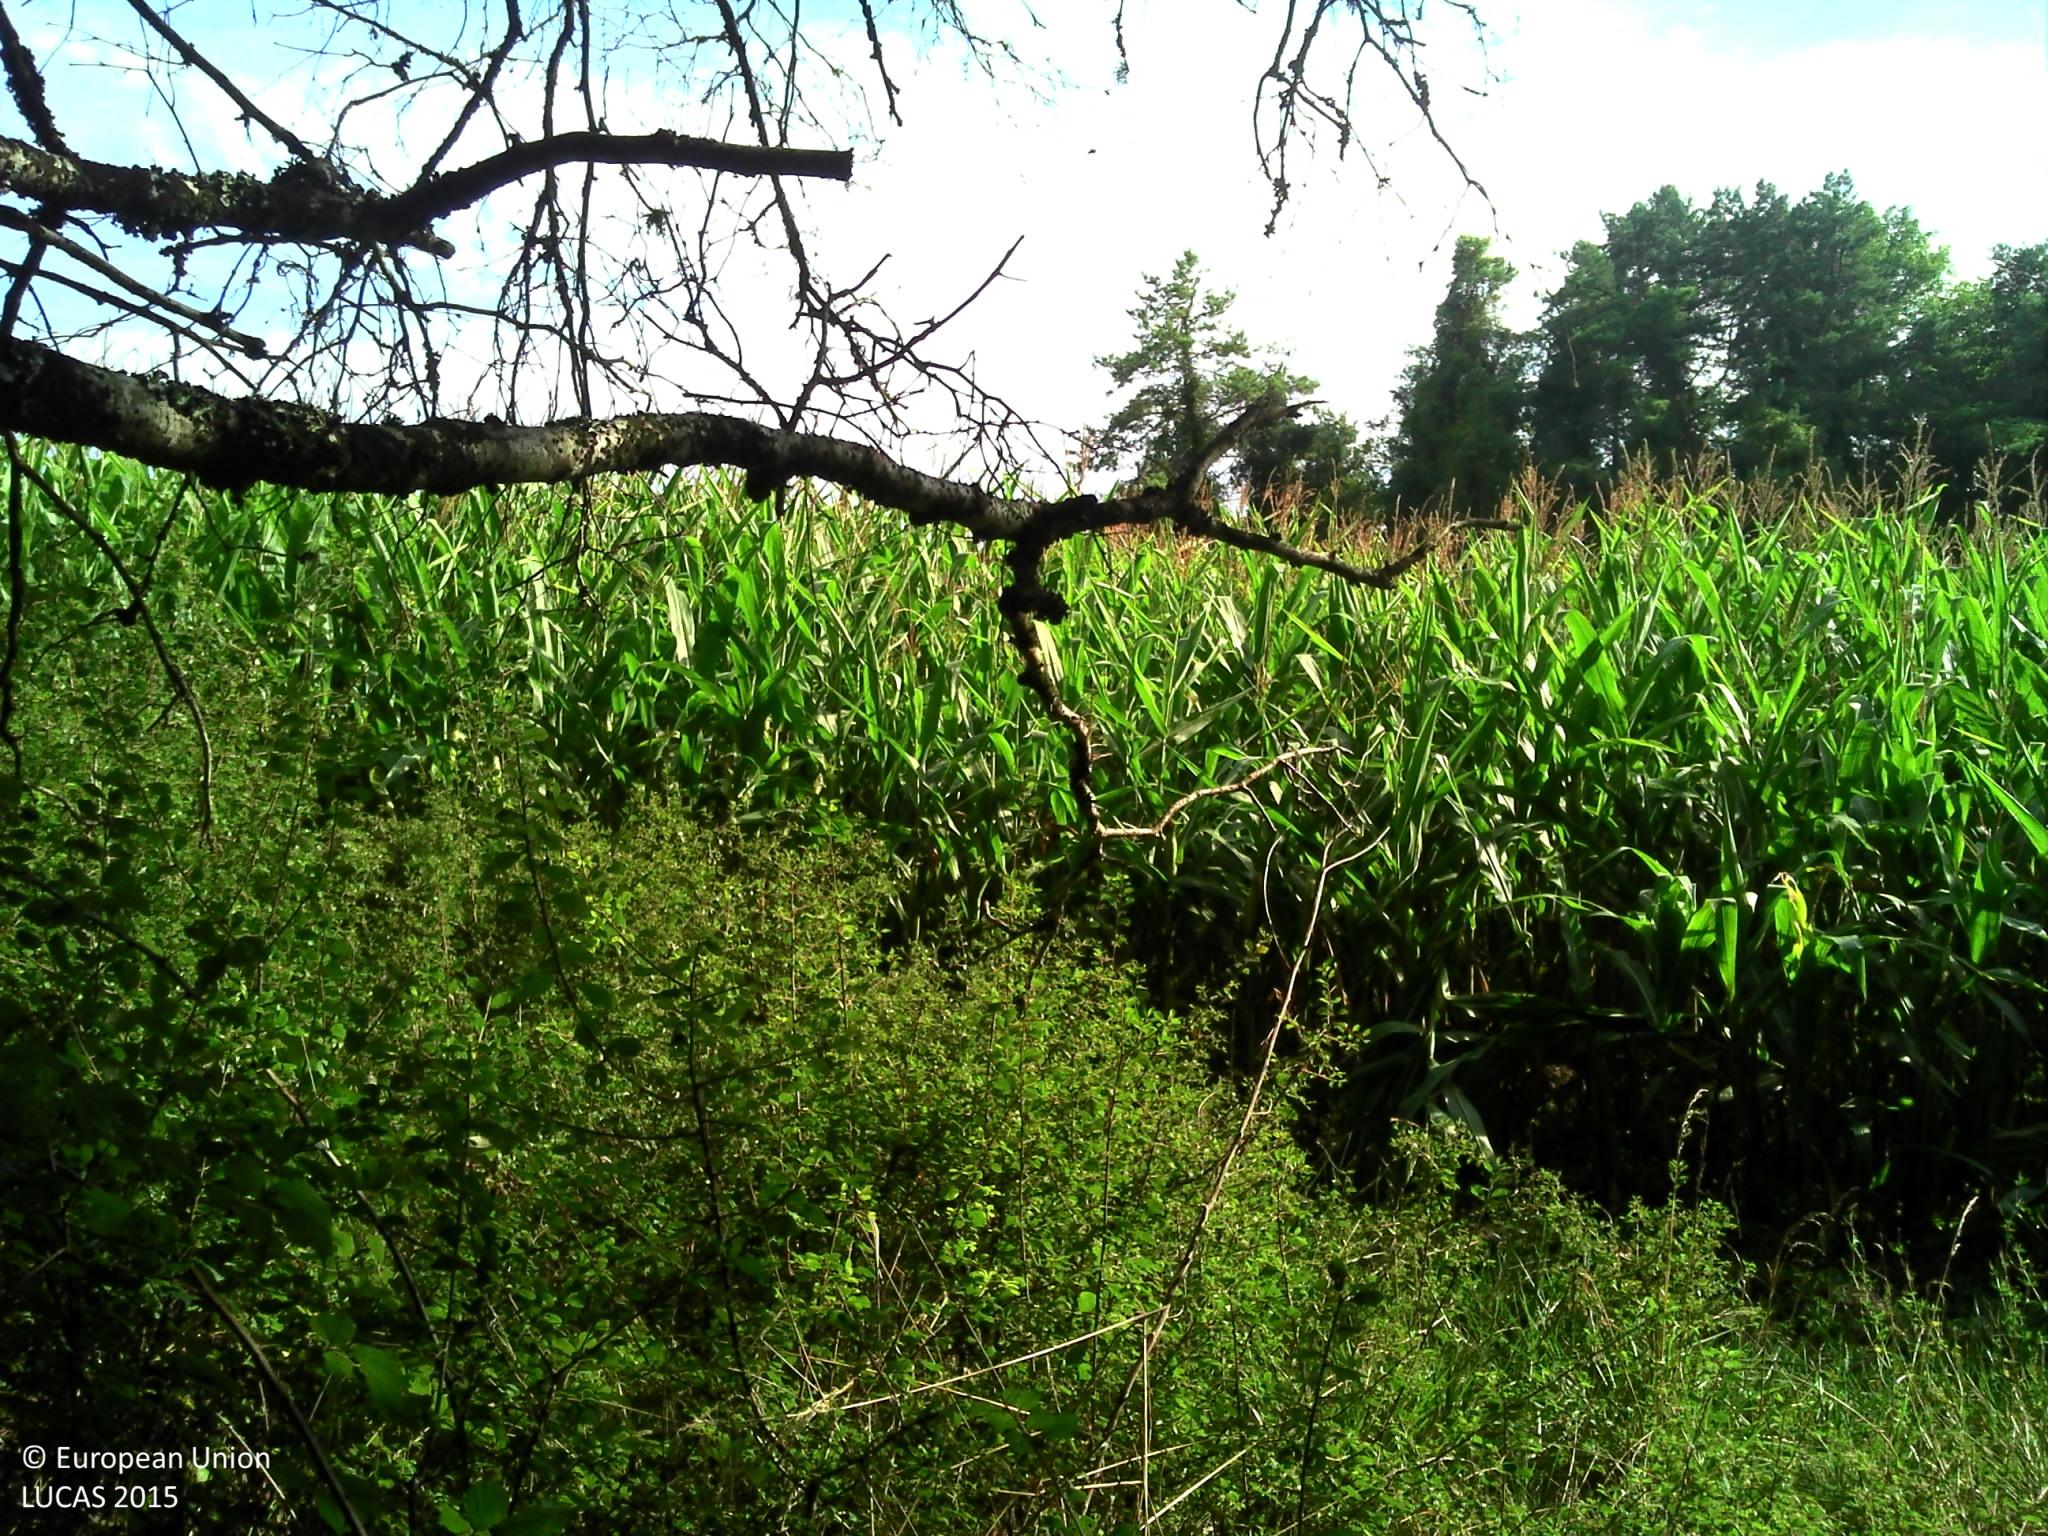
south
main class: Woodland
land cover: Broadleaved woodland
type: mesophytic deciduous forest
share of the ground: > 75 %
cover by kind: broadleaved forest trees 60 %, herbaceous plants 20 %, shrubs 10 %, lichens and mosses 10 %
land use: Forestry
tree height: > 5 m
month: August
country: FR
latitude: 45.4191
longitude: 0.4923
